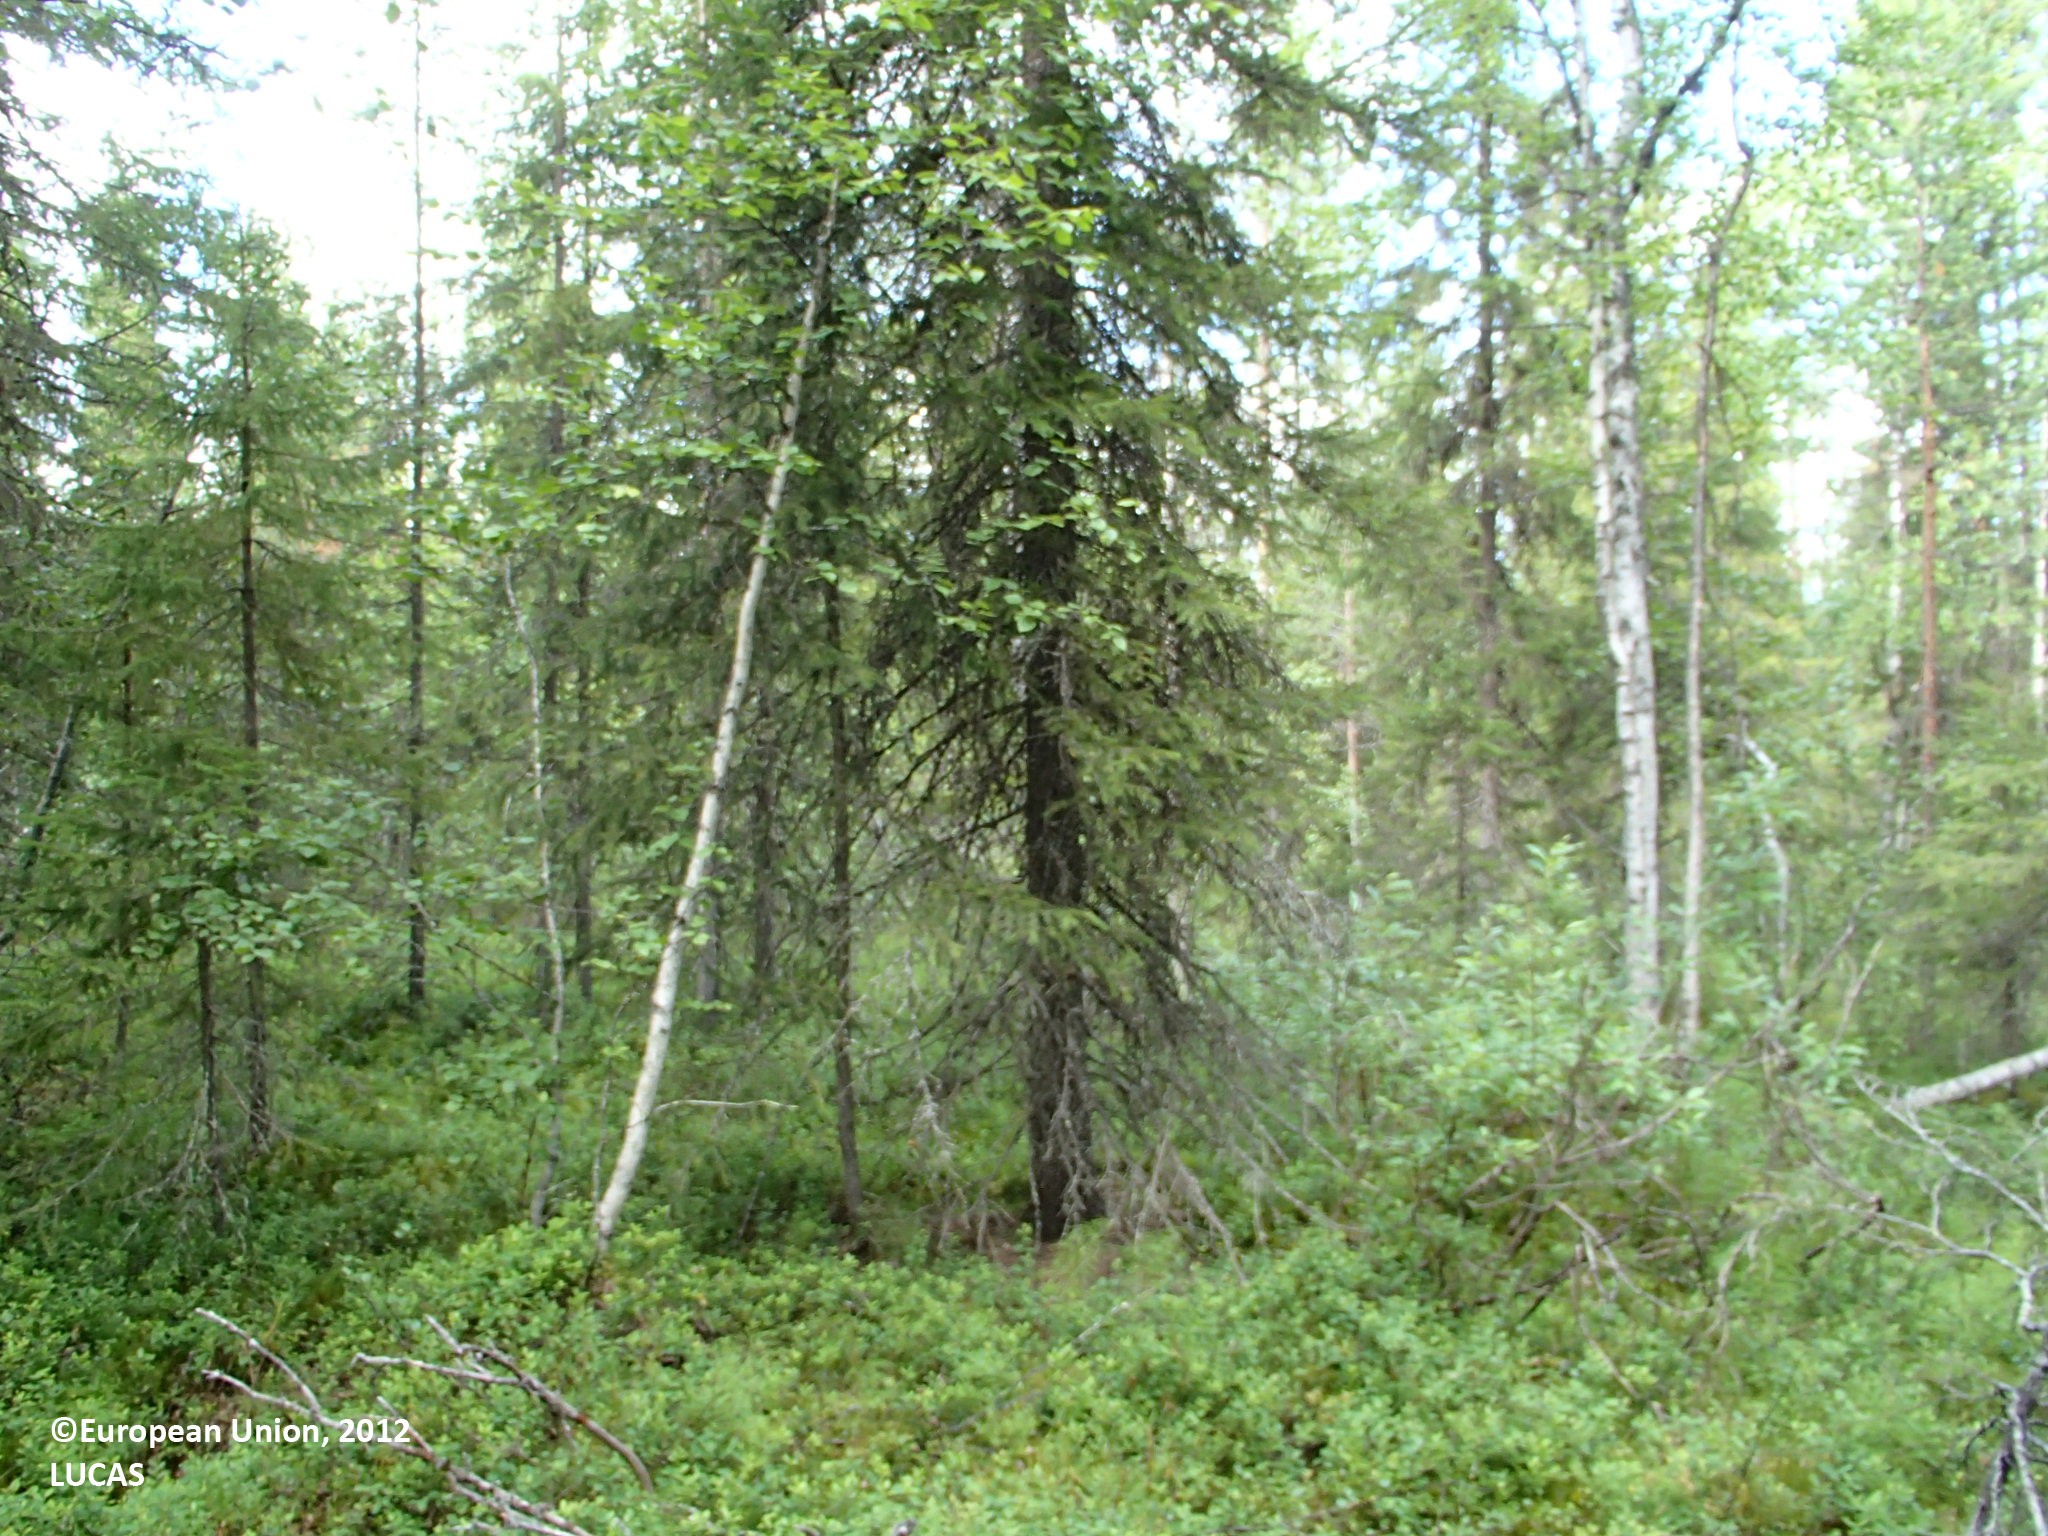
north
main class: Woodland
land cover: Spruce dominated mixed woodland
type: boreal forest
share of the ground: > 75 %
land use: Forestry
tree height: > 5 m
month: July
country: FI
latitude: 66.6984
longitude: 25.3496
